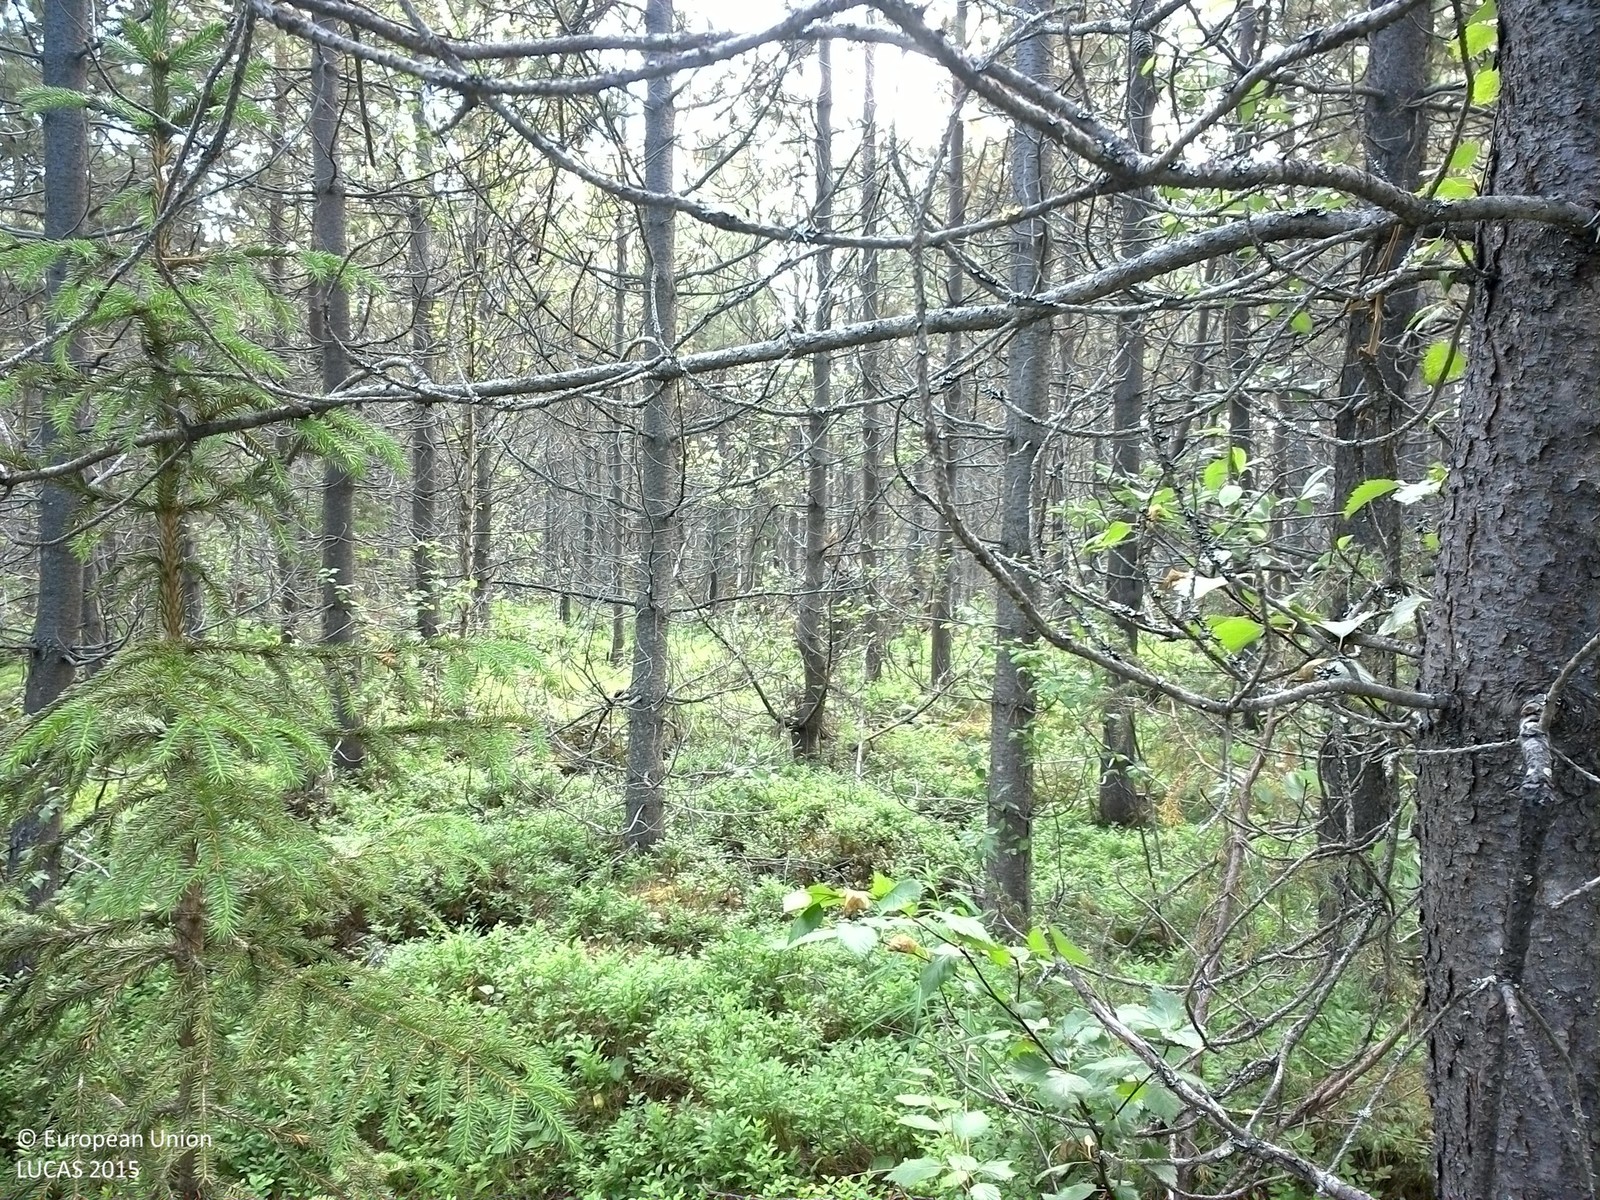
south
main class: Woodland
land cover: Pine dominated coniferous woodland
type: exotic forest
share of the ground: 50 - 75 %
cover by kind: coniferous forest trees 55 %, shrubs 15 %, broadleaved forest trees 10 %, herbaceous plants 10 %, lichens and mosses 10 %
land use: Forestry
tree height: > 5 m
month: July
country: SE
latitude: 64.6131
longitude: 15.4259
